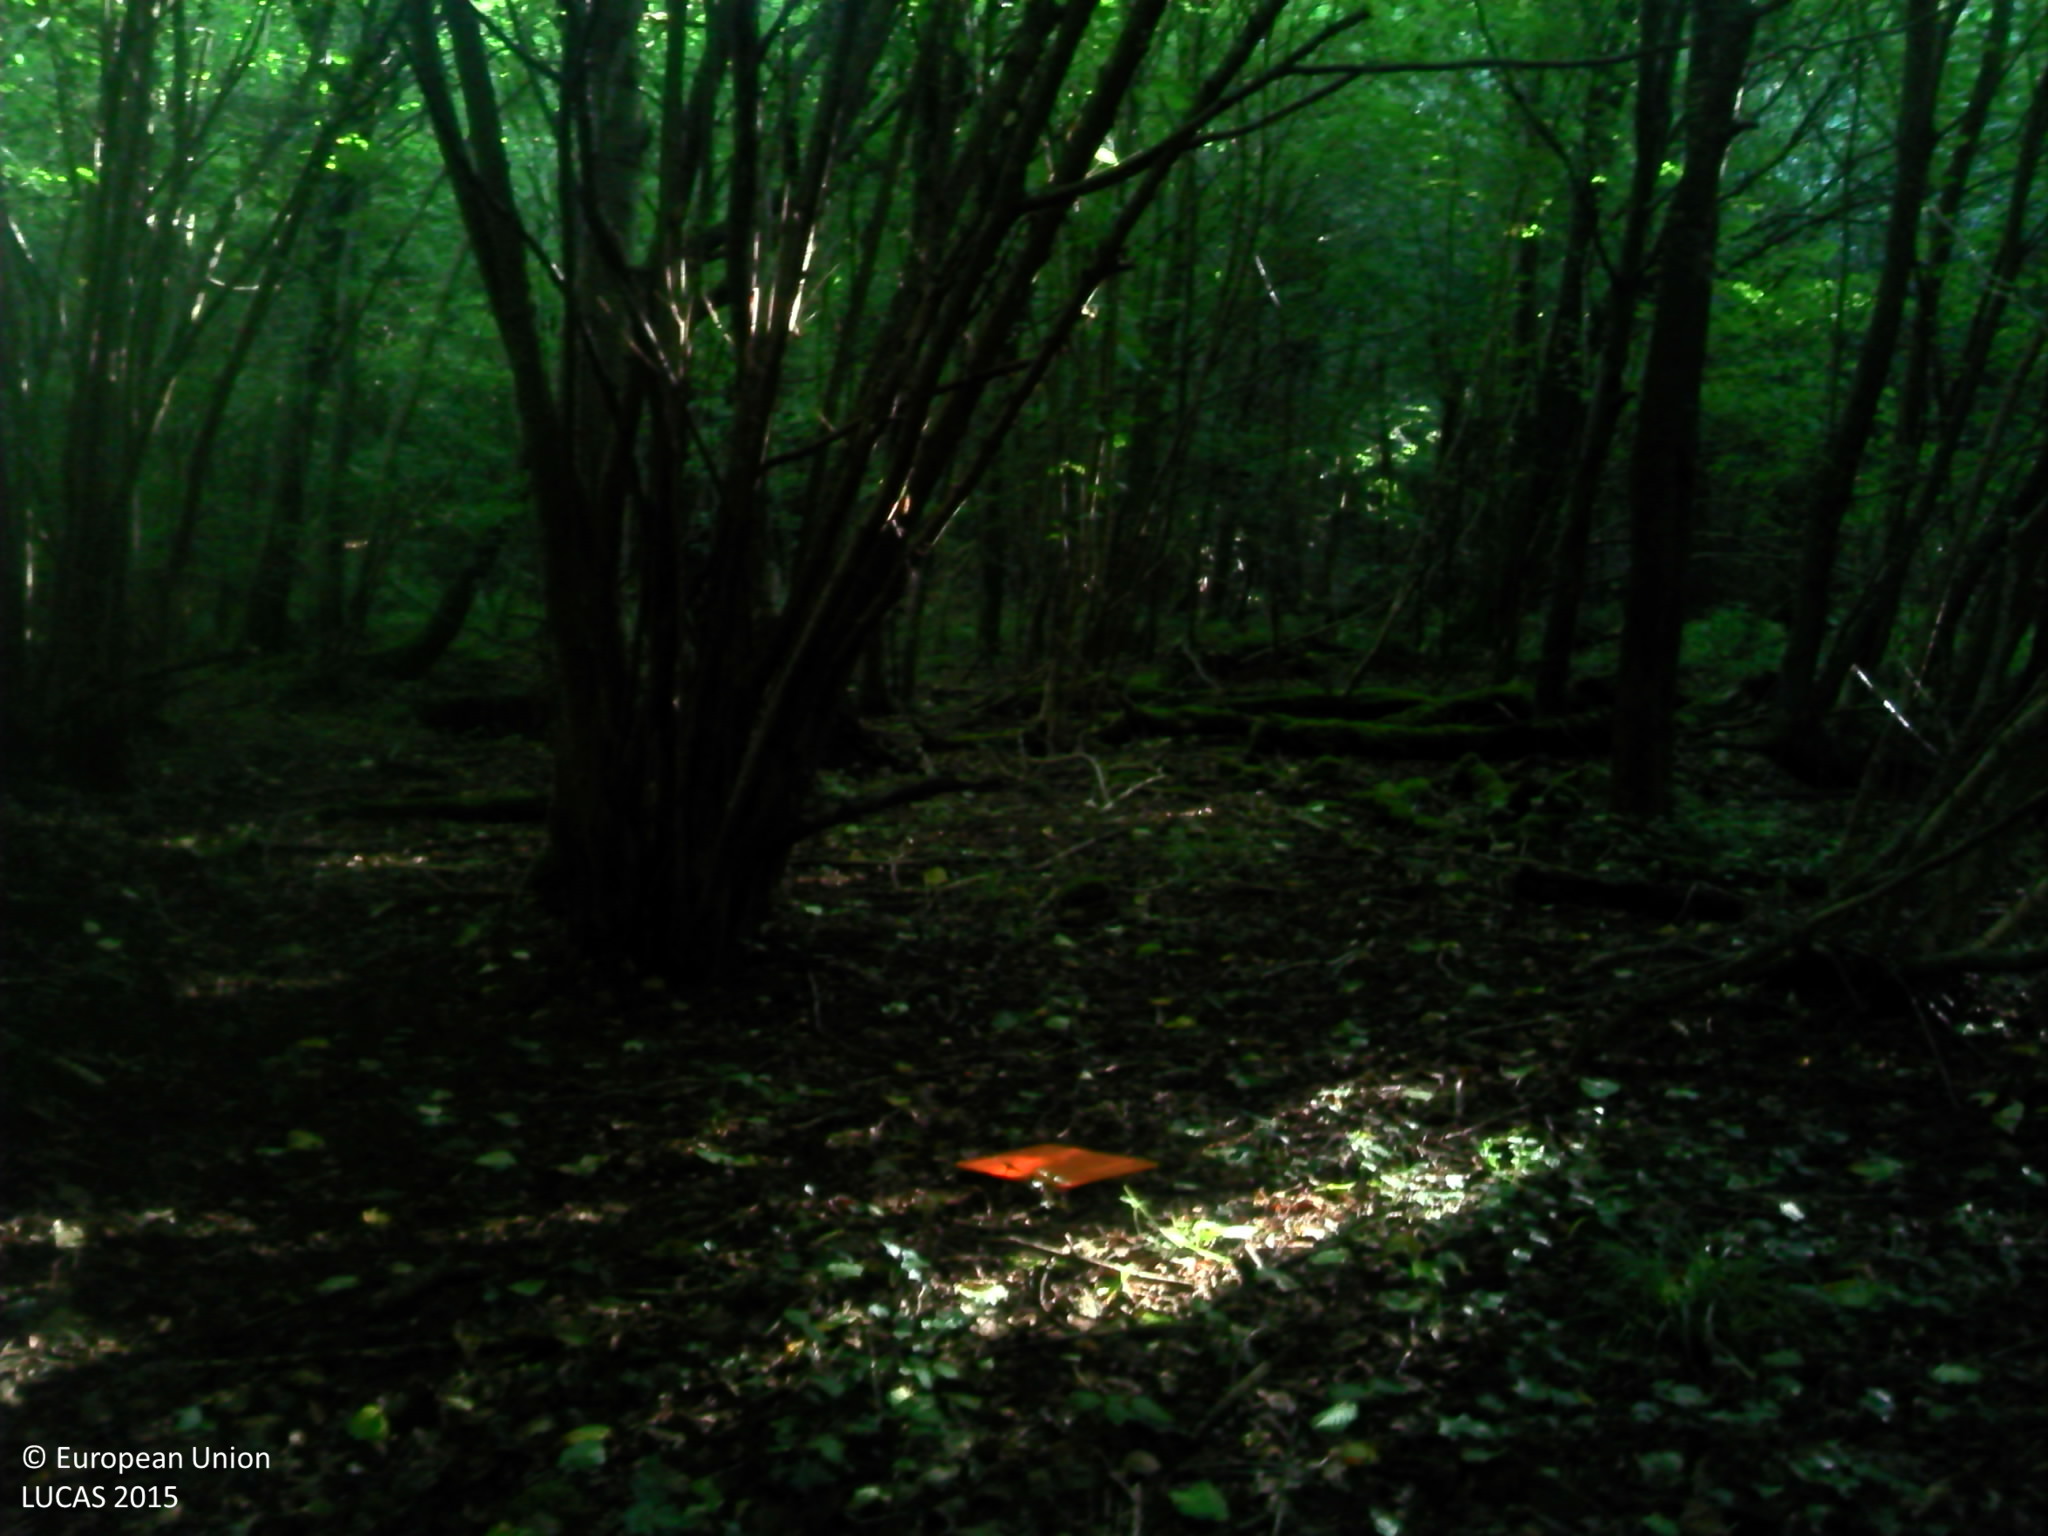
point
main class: Woodland
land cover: Broadleaved woodland
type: acidophilous oak and oak-birch forest
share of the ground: > 75 %
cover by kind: broadleaved forest trees 70 %, lichens and mosses 15 %, shrubs 10 %, herbaceous plants 5 %
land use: Forestry
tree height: > 5 m
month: September
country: FR
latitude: 48.3998
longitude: 0.5888
